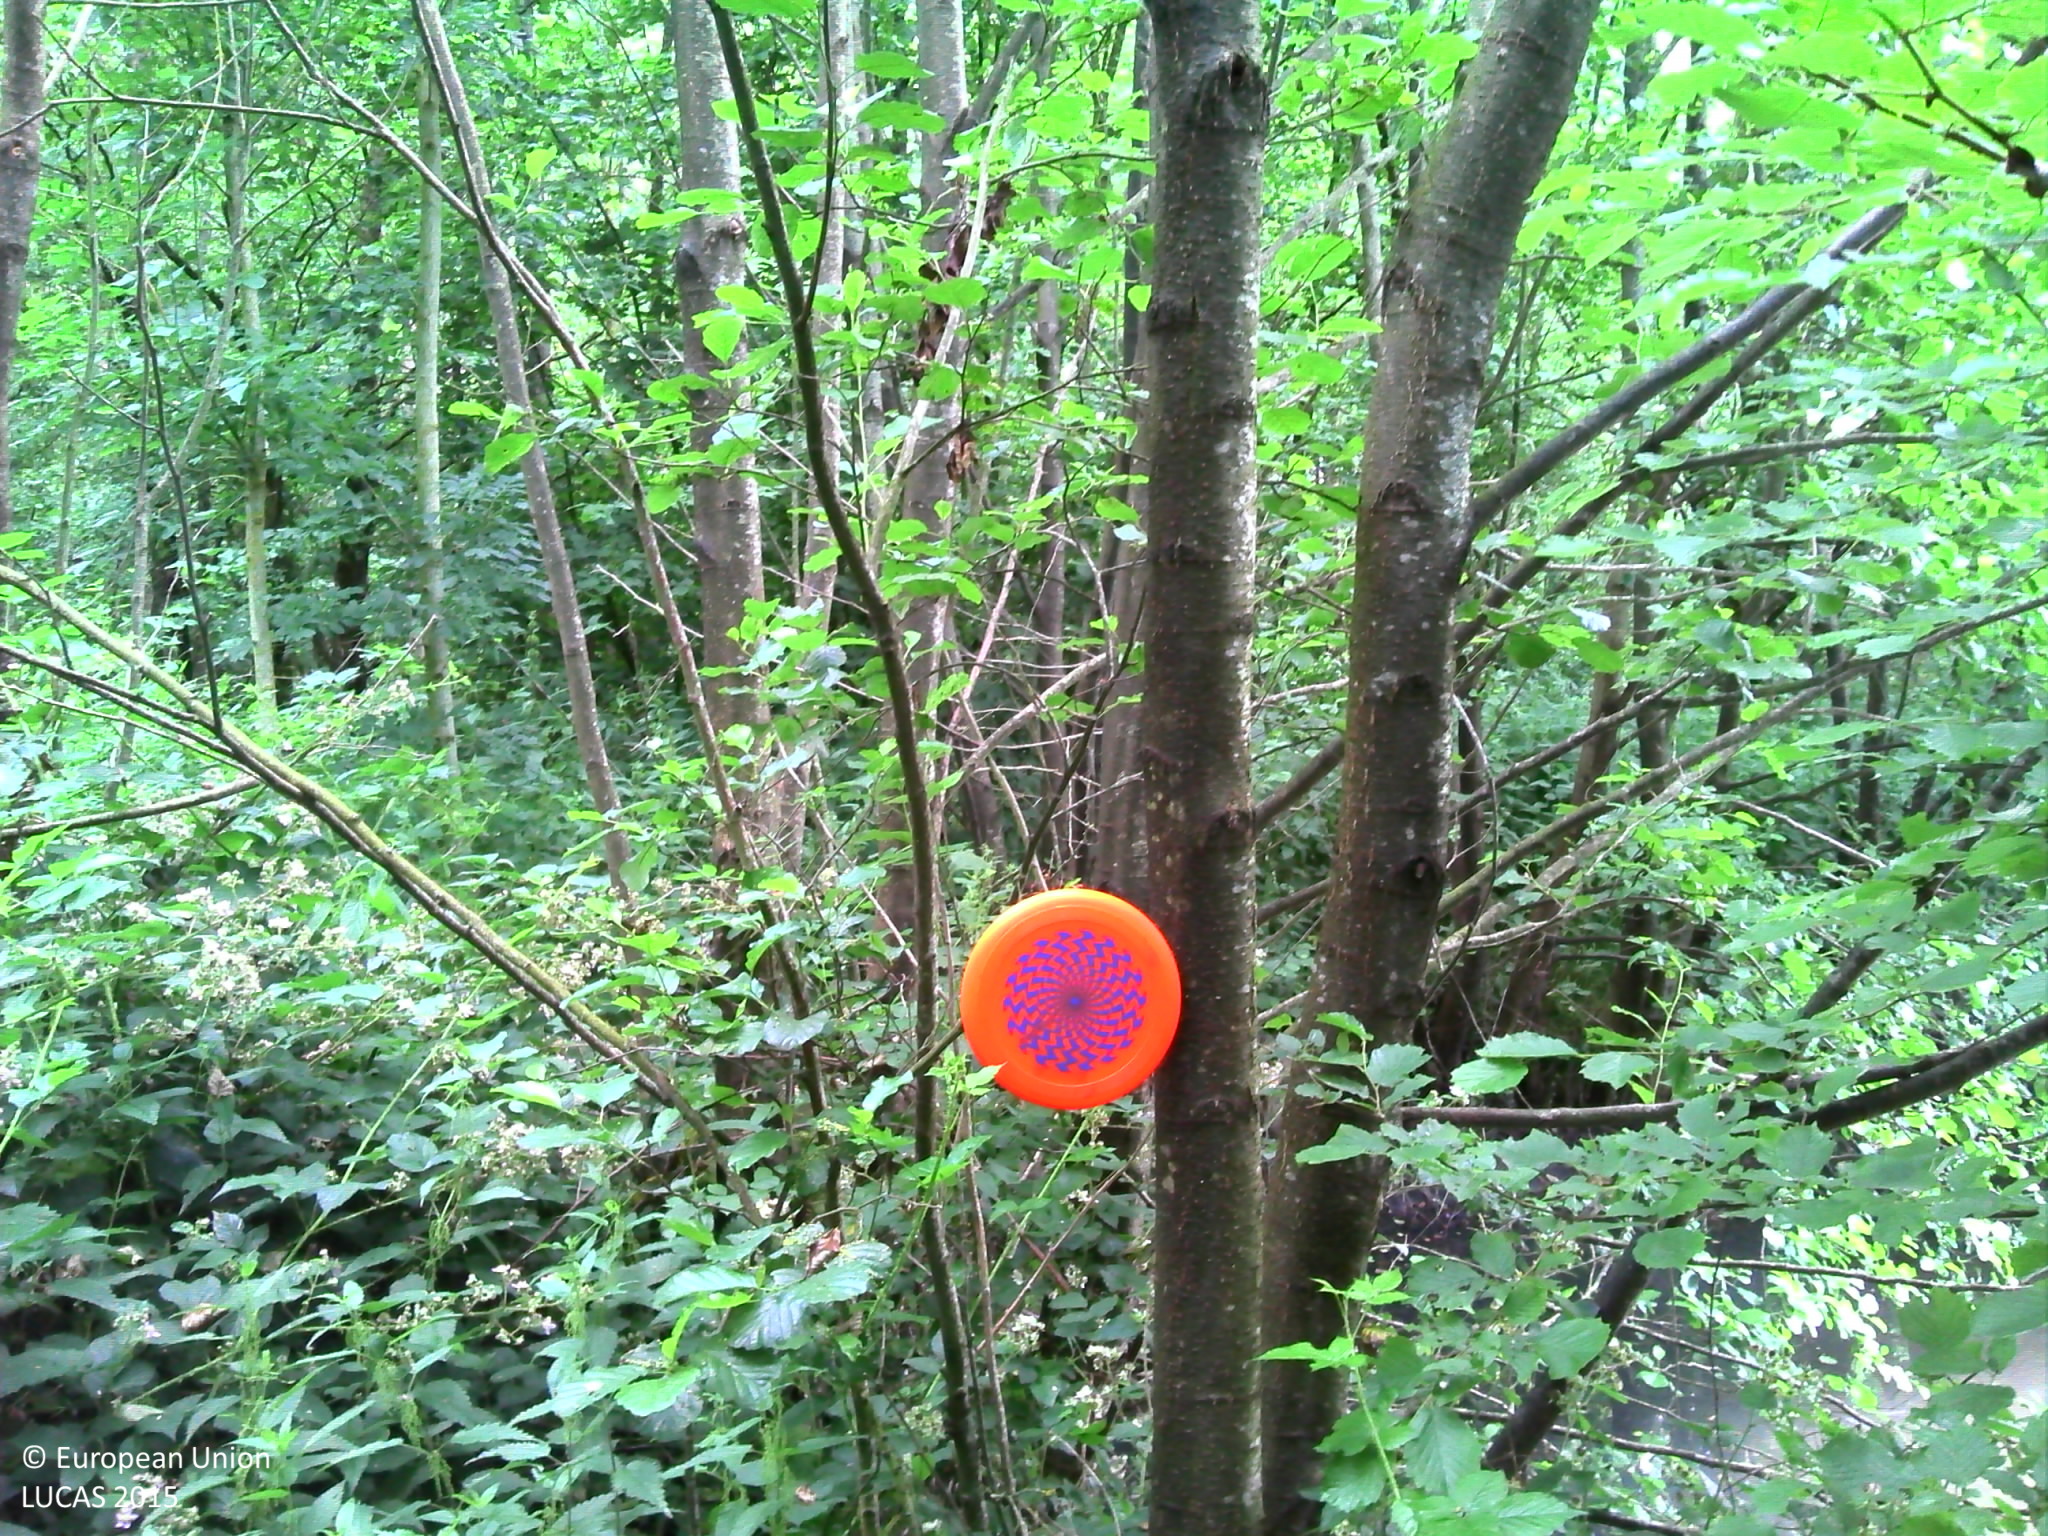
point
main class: Woodland
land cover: Broadleaved woodland
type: floodplain forest
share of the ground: > 75 %
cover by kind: broadleaved forest trees 95 %, herbaceous plants 5 %
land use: Forestry
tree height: > 5 m
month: July
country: BE
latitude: 50.2750
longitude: 4.6503
